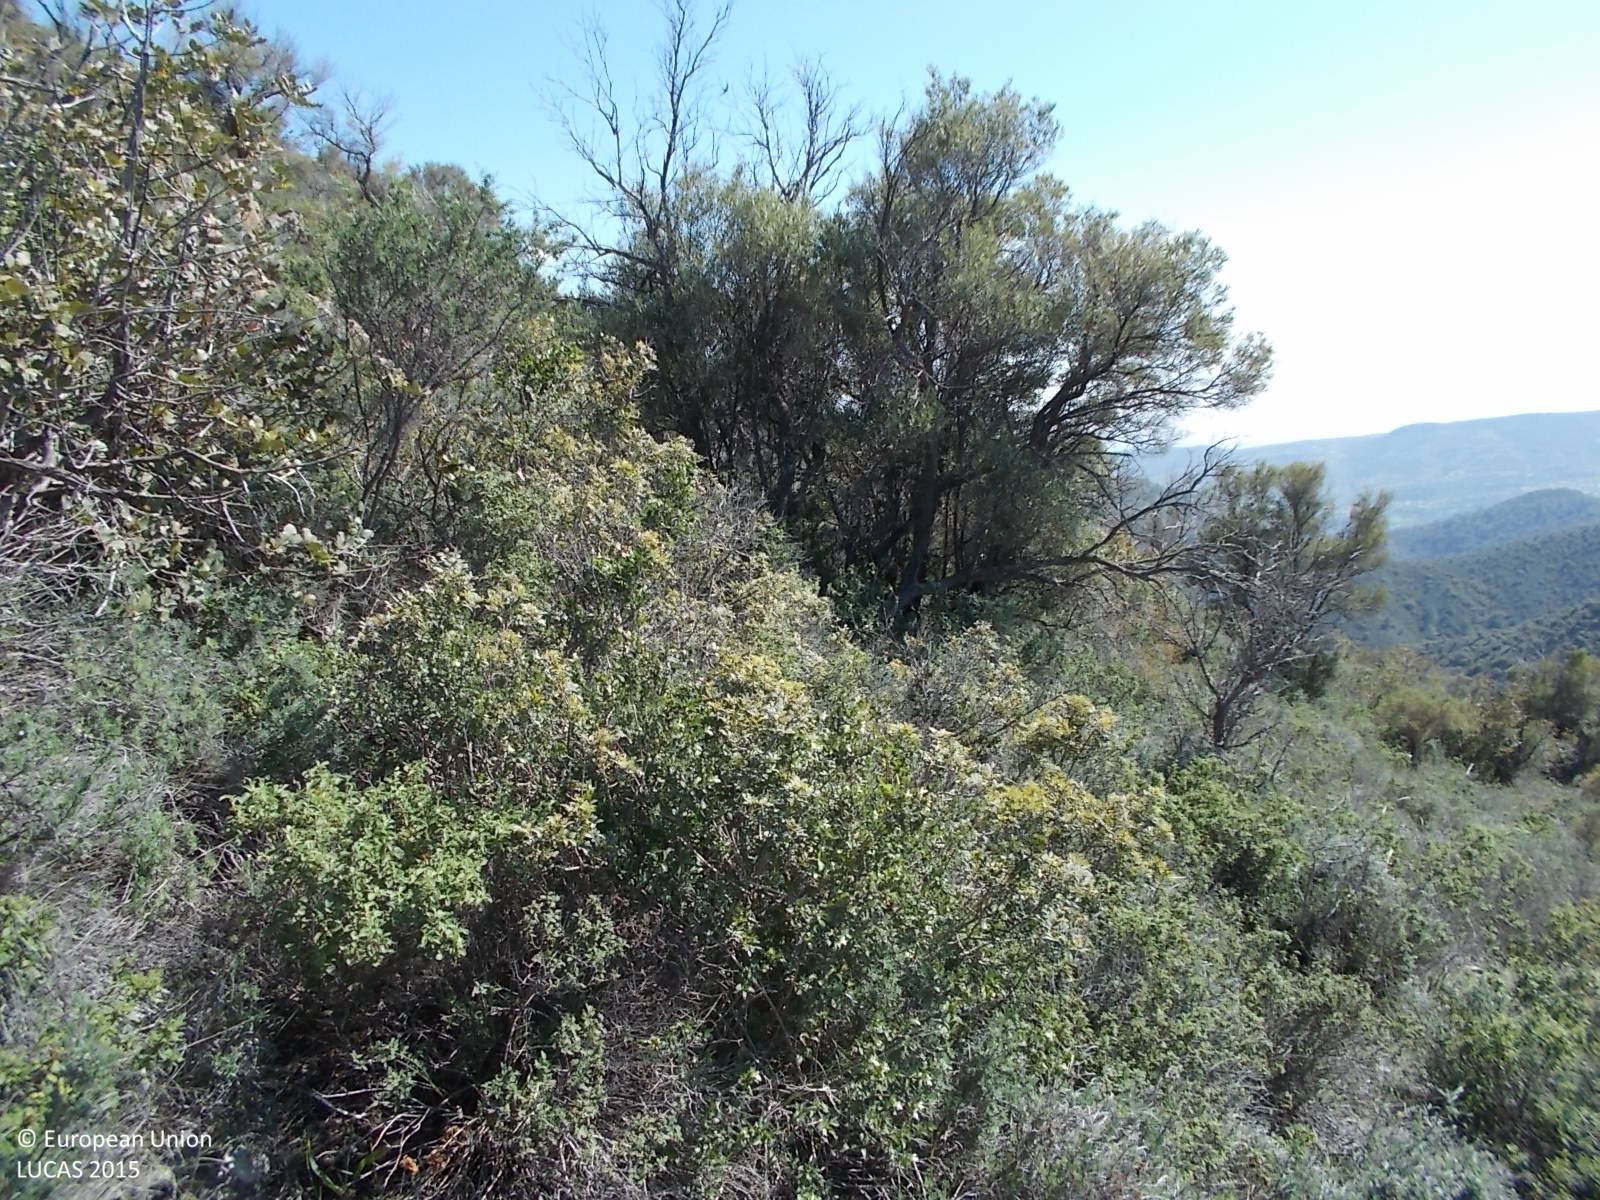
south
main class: Woodland
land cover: Other mixed woodland
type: coniferous forest of the mediterranean region
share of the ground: > 75 %
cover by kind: shrubs 60 %, coniferous forest trees 20 %, broadleaved forest trees 20 %
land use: Semi-natural and natural areas not in use
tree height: < 5 m
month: April
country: CY
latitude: 34.8075
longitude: 33.0938
